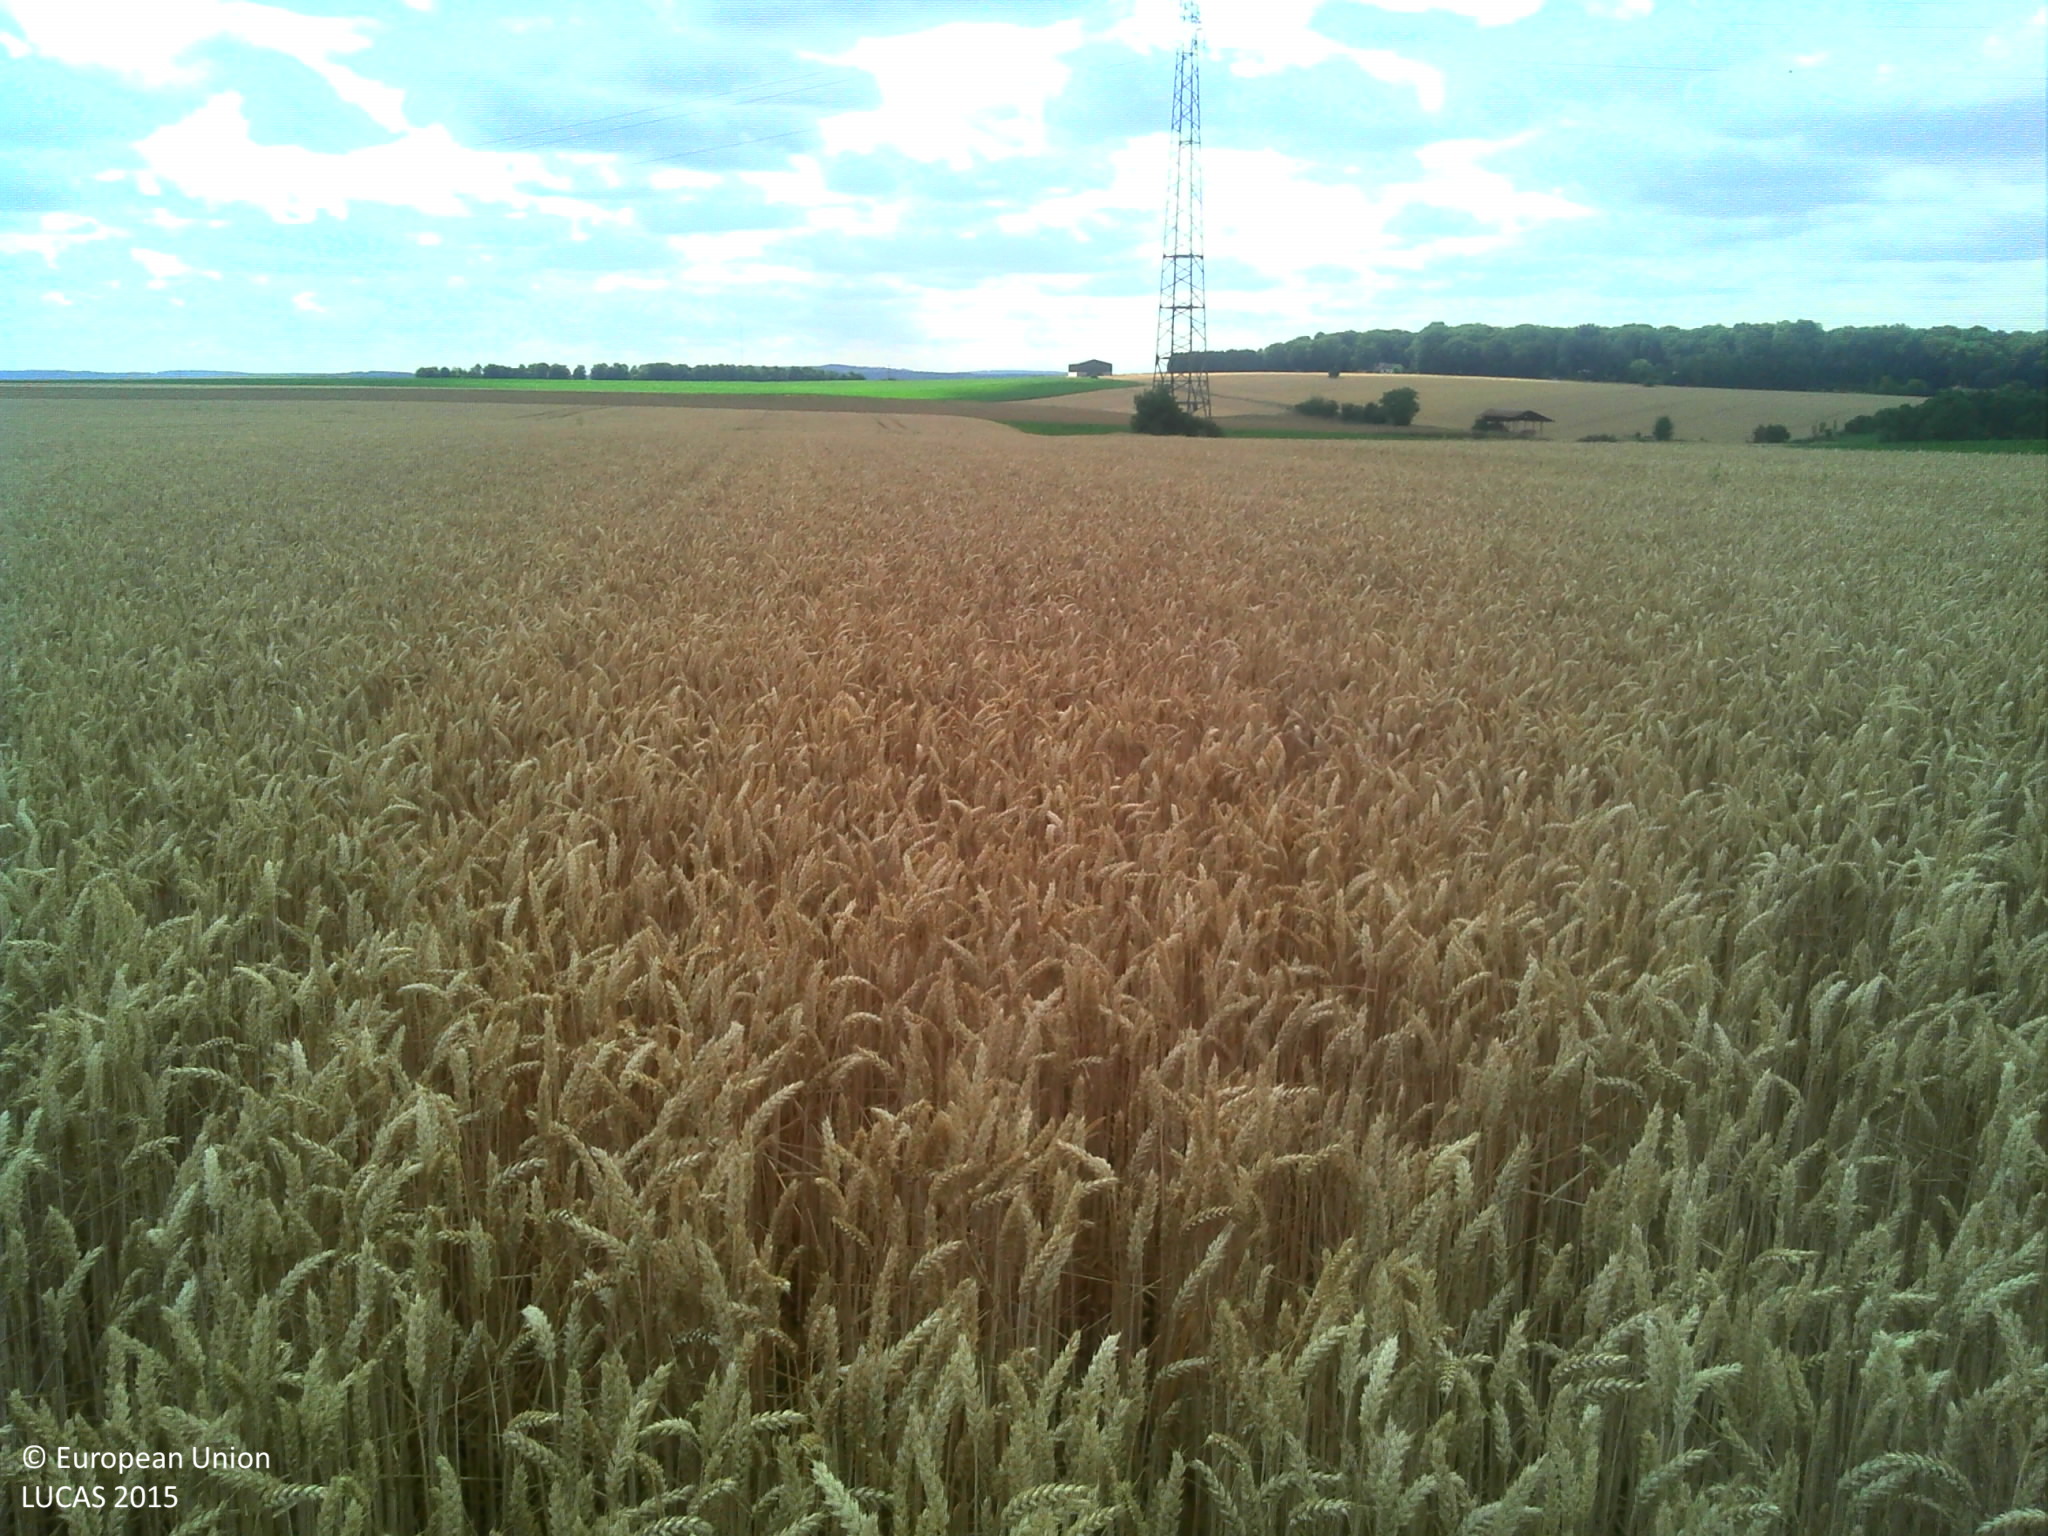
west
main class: Cropland
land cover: Common wheat
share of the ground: > 75 %
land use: Agriculture (excluding fallow land and kitchen gardens)
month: July
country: FR
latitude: 49.2831
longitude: 3.2973
